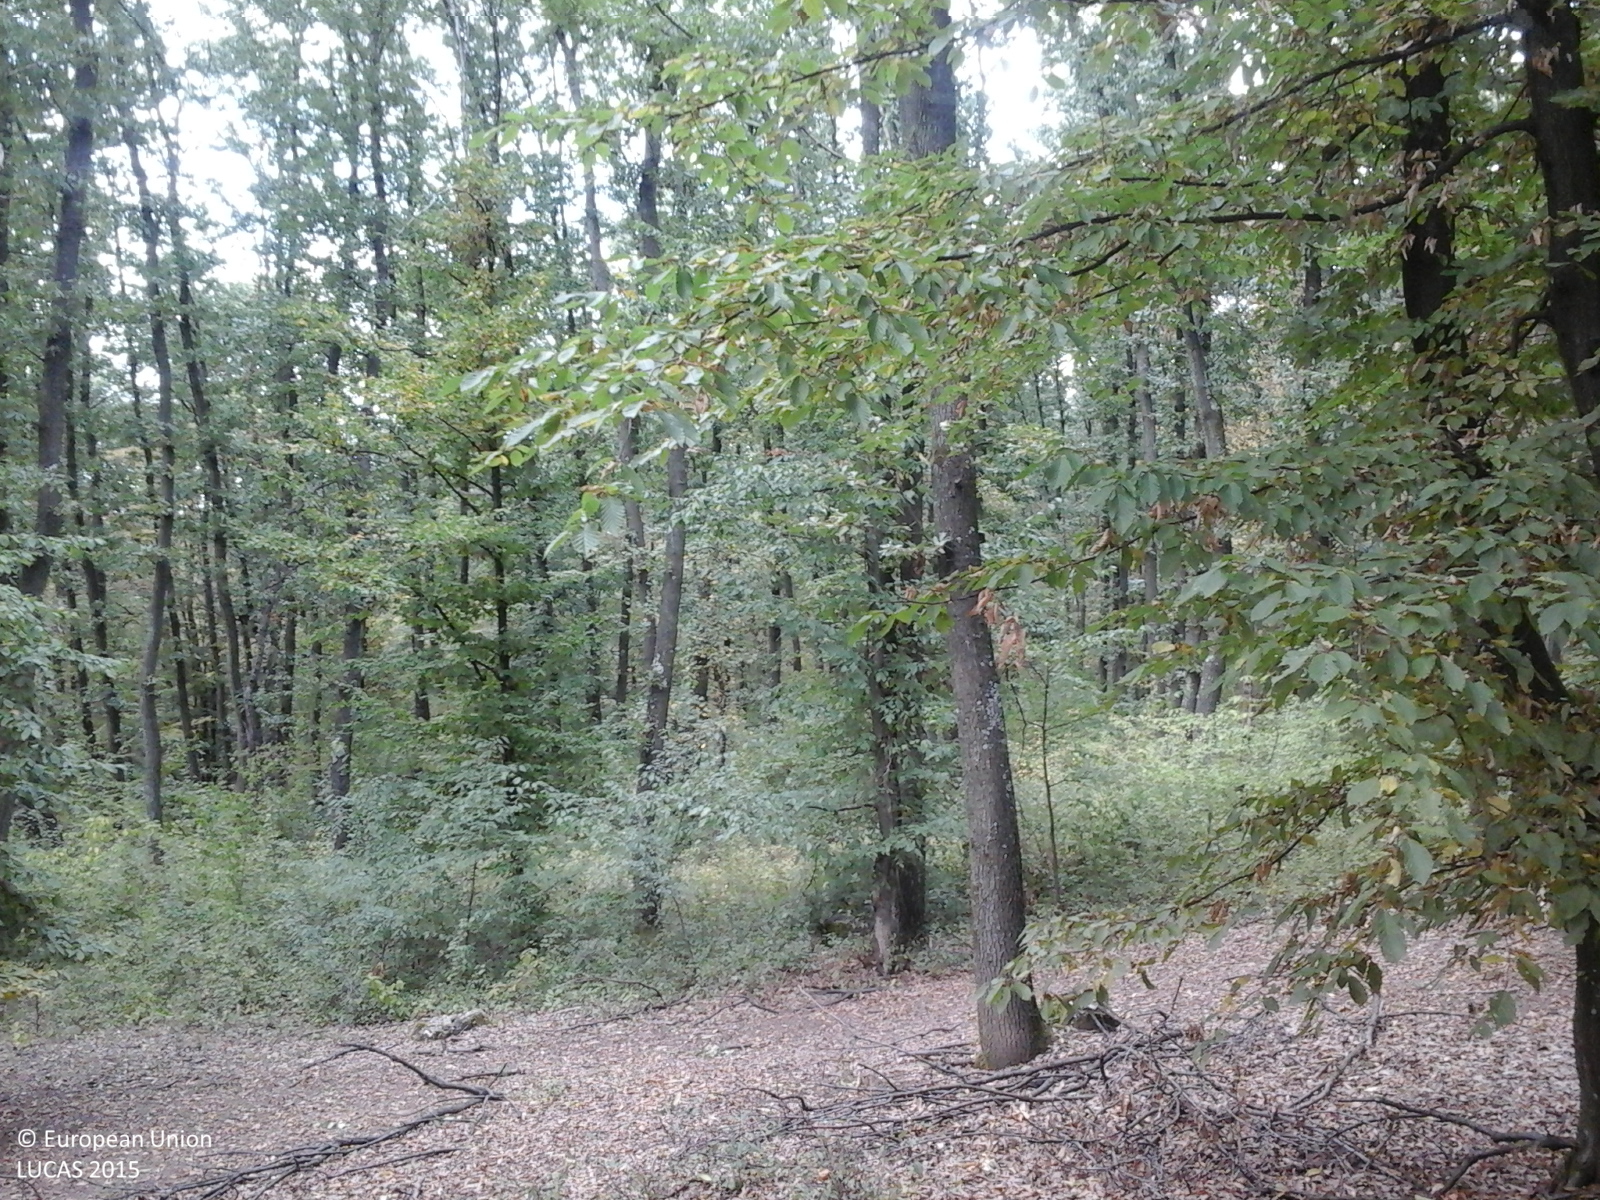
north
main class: Woodland
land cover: Broadleaved woodland
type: mesophytic deciduous forest
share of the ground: > 75 %
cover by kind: broadleaved forest trees 100 %
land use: Forestry
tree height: > 5 m
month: September
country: RO
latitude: 47.3044
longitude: 23.1472
